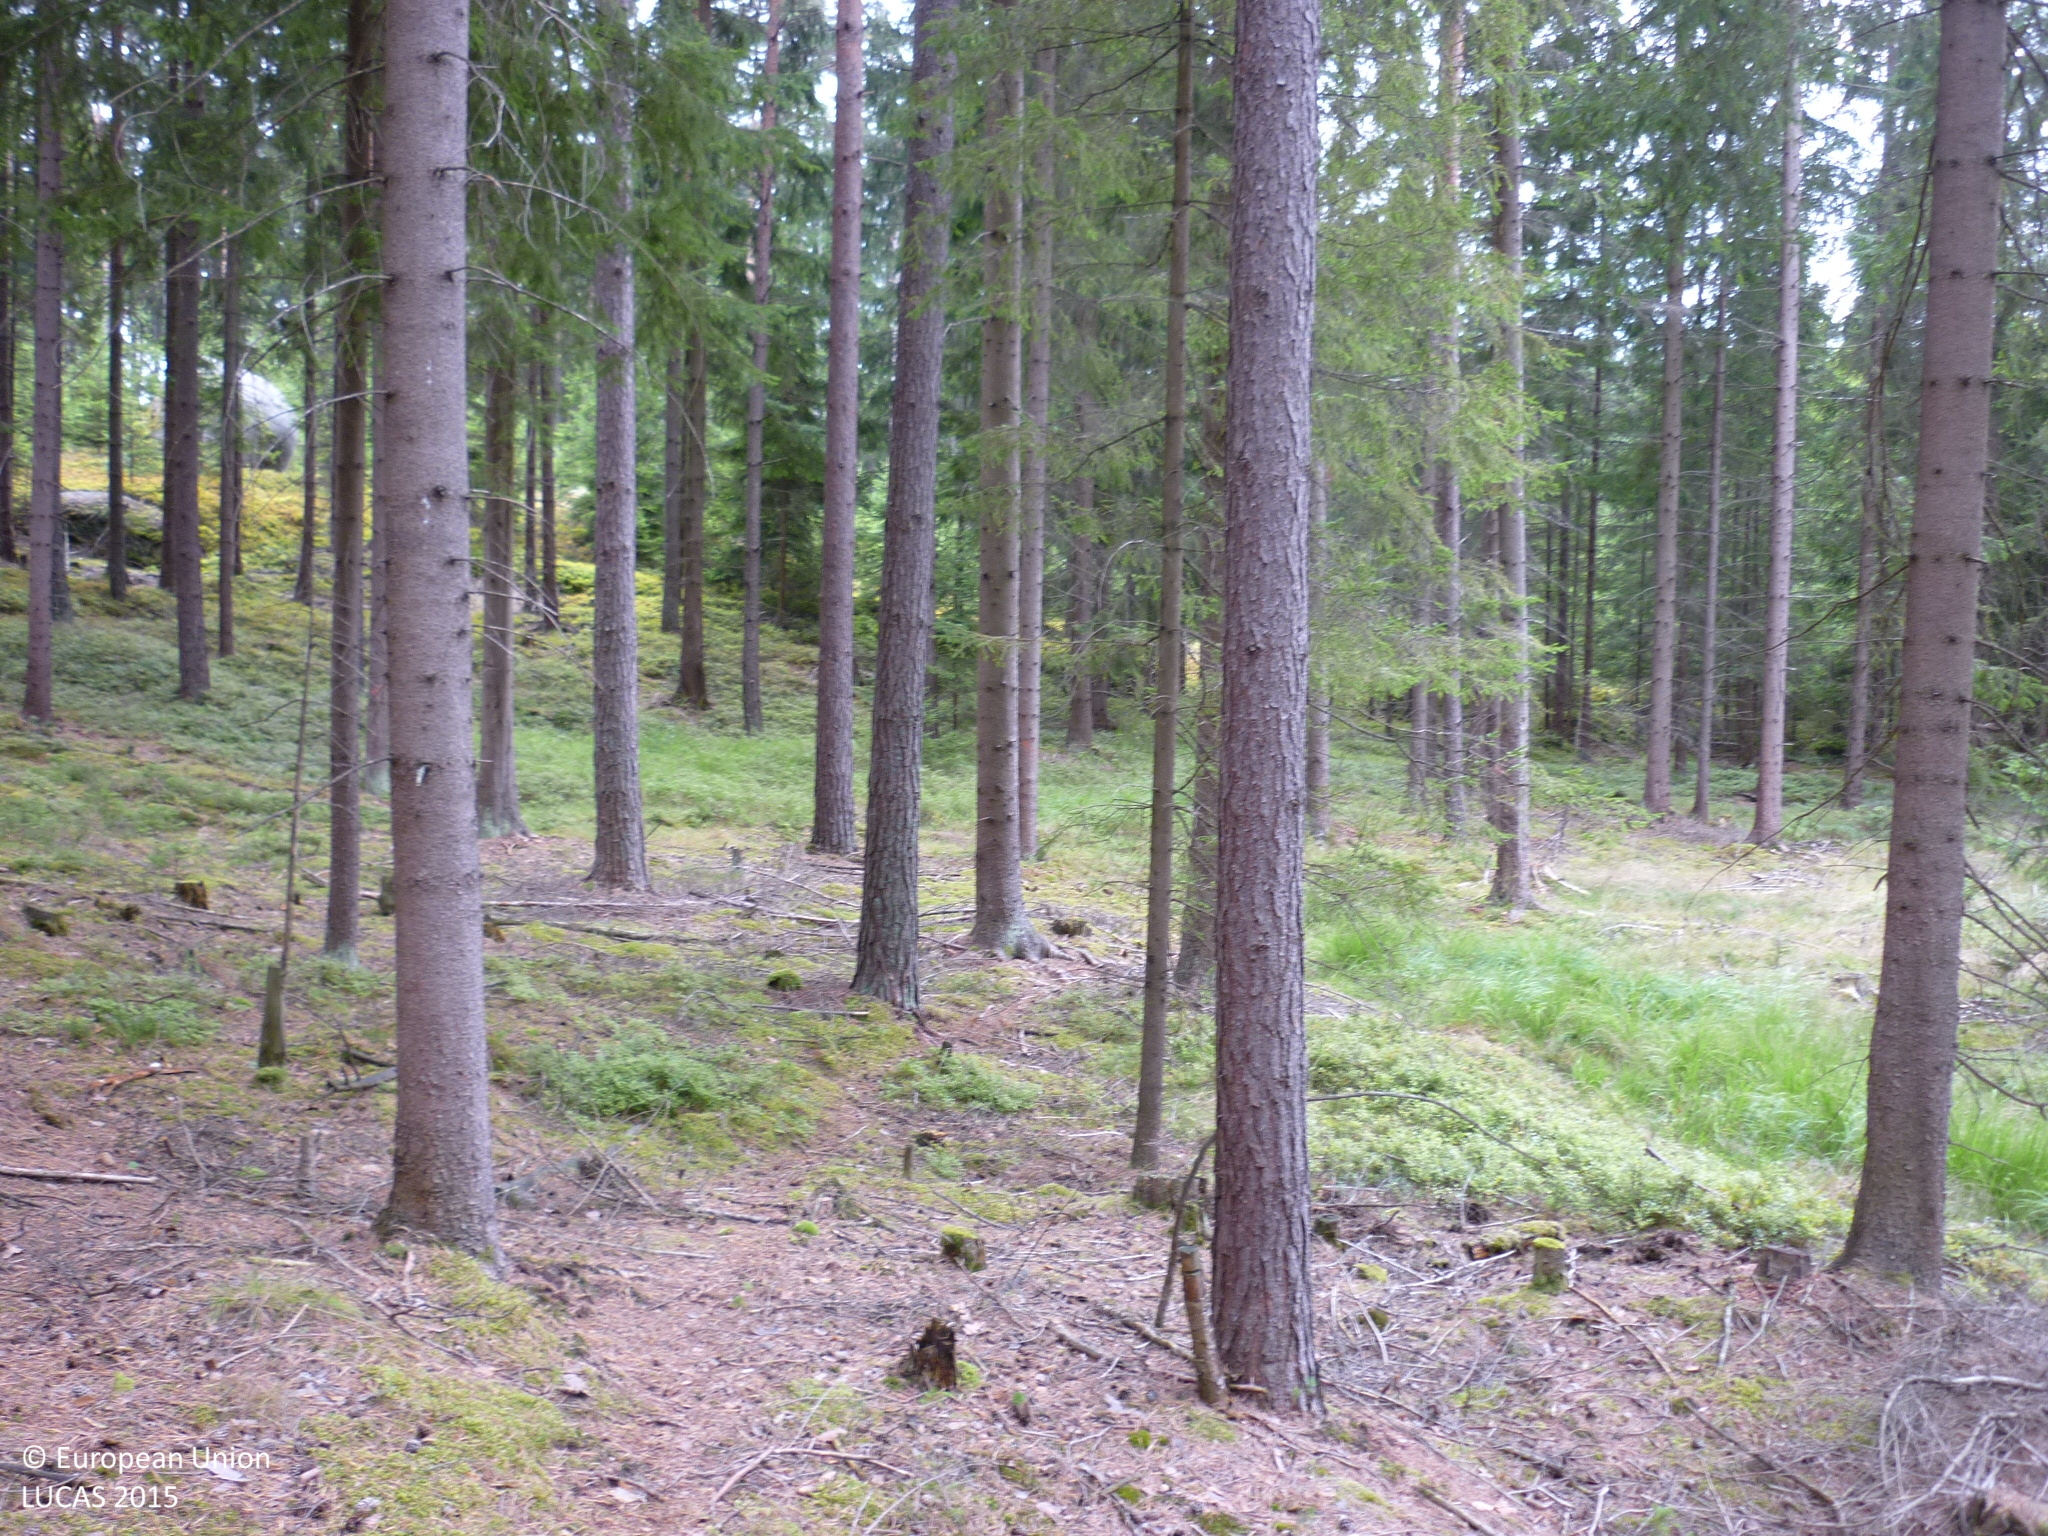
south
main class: Woodland
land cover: Spruce dominated coniferous woodland
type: hemiboreal forest and nemoral coniferous forest and mixed broadleaved-coniferous forest
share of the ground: > 75 %
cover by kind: coniferous forest trees 100 %
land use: Forestry
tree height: > 5 m
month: September
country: AT
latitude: 48.8479
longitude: 15.0305
